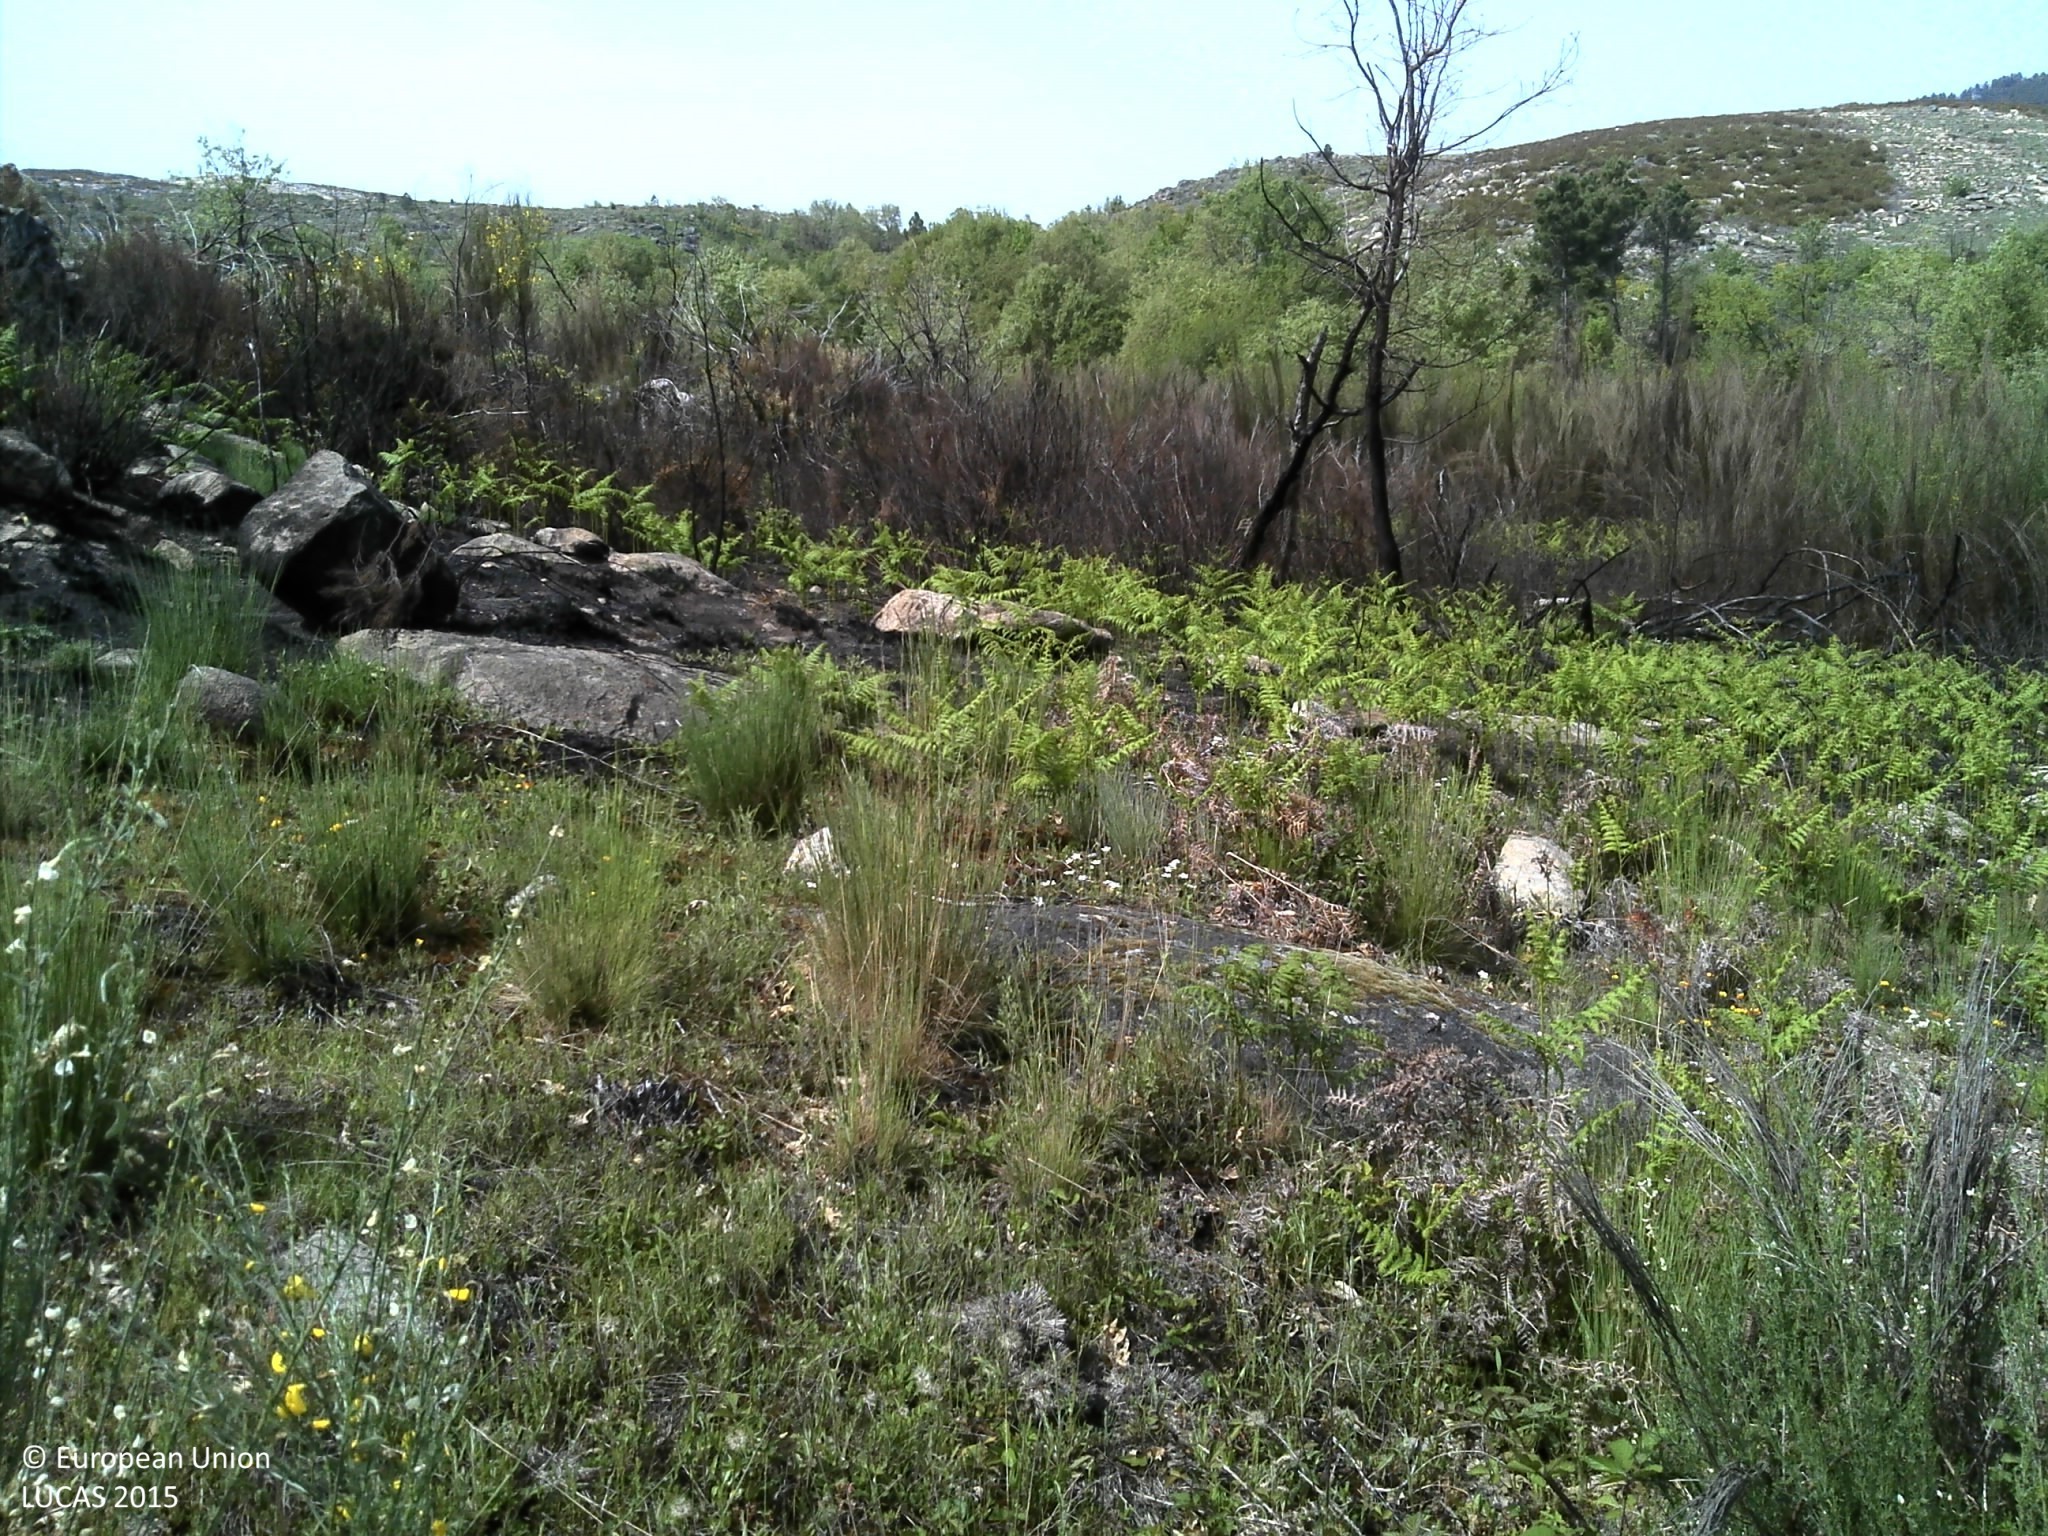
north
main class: Shrubland
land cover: Shrubland with sparse tree cover
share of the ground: 50 - 75 %
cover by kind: shrubs 70 %, unconsolidated bare surface 15 %, herbaceous plants 10 %, broadleaved forest trees 5 %
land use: Forestry
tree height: < 5 m
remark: Burnt area
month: May
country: PT
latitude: 41.9608
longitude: -7.0999
